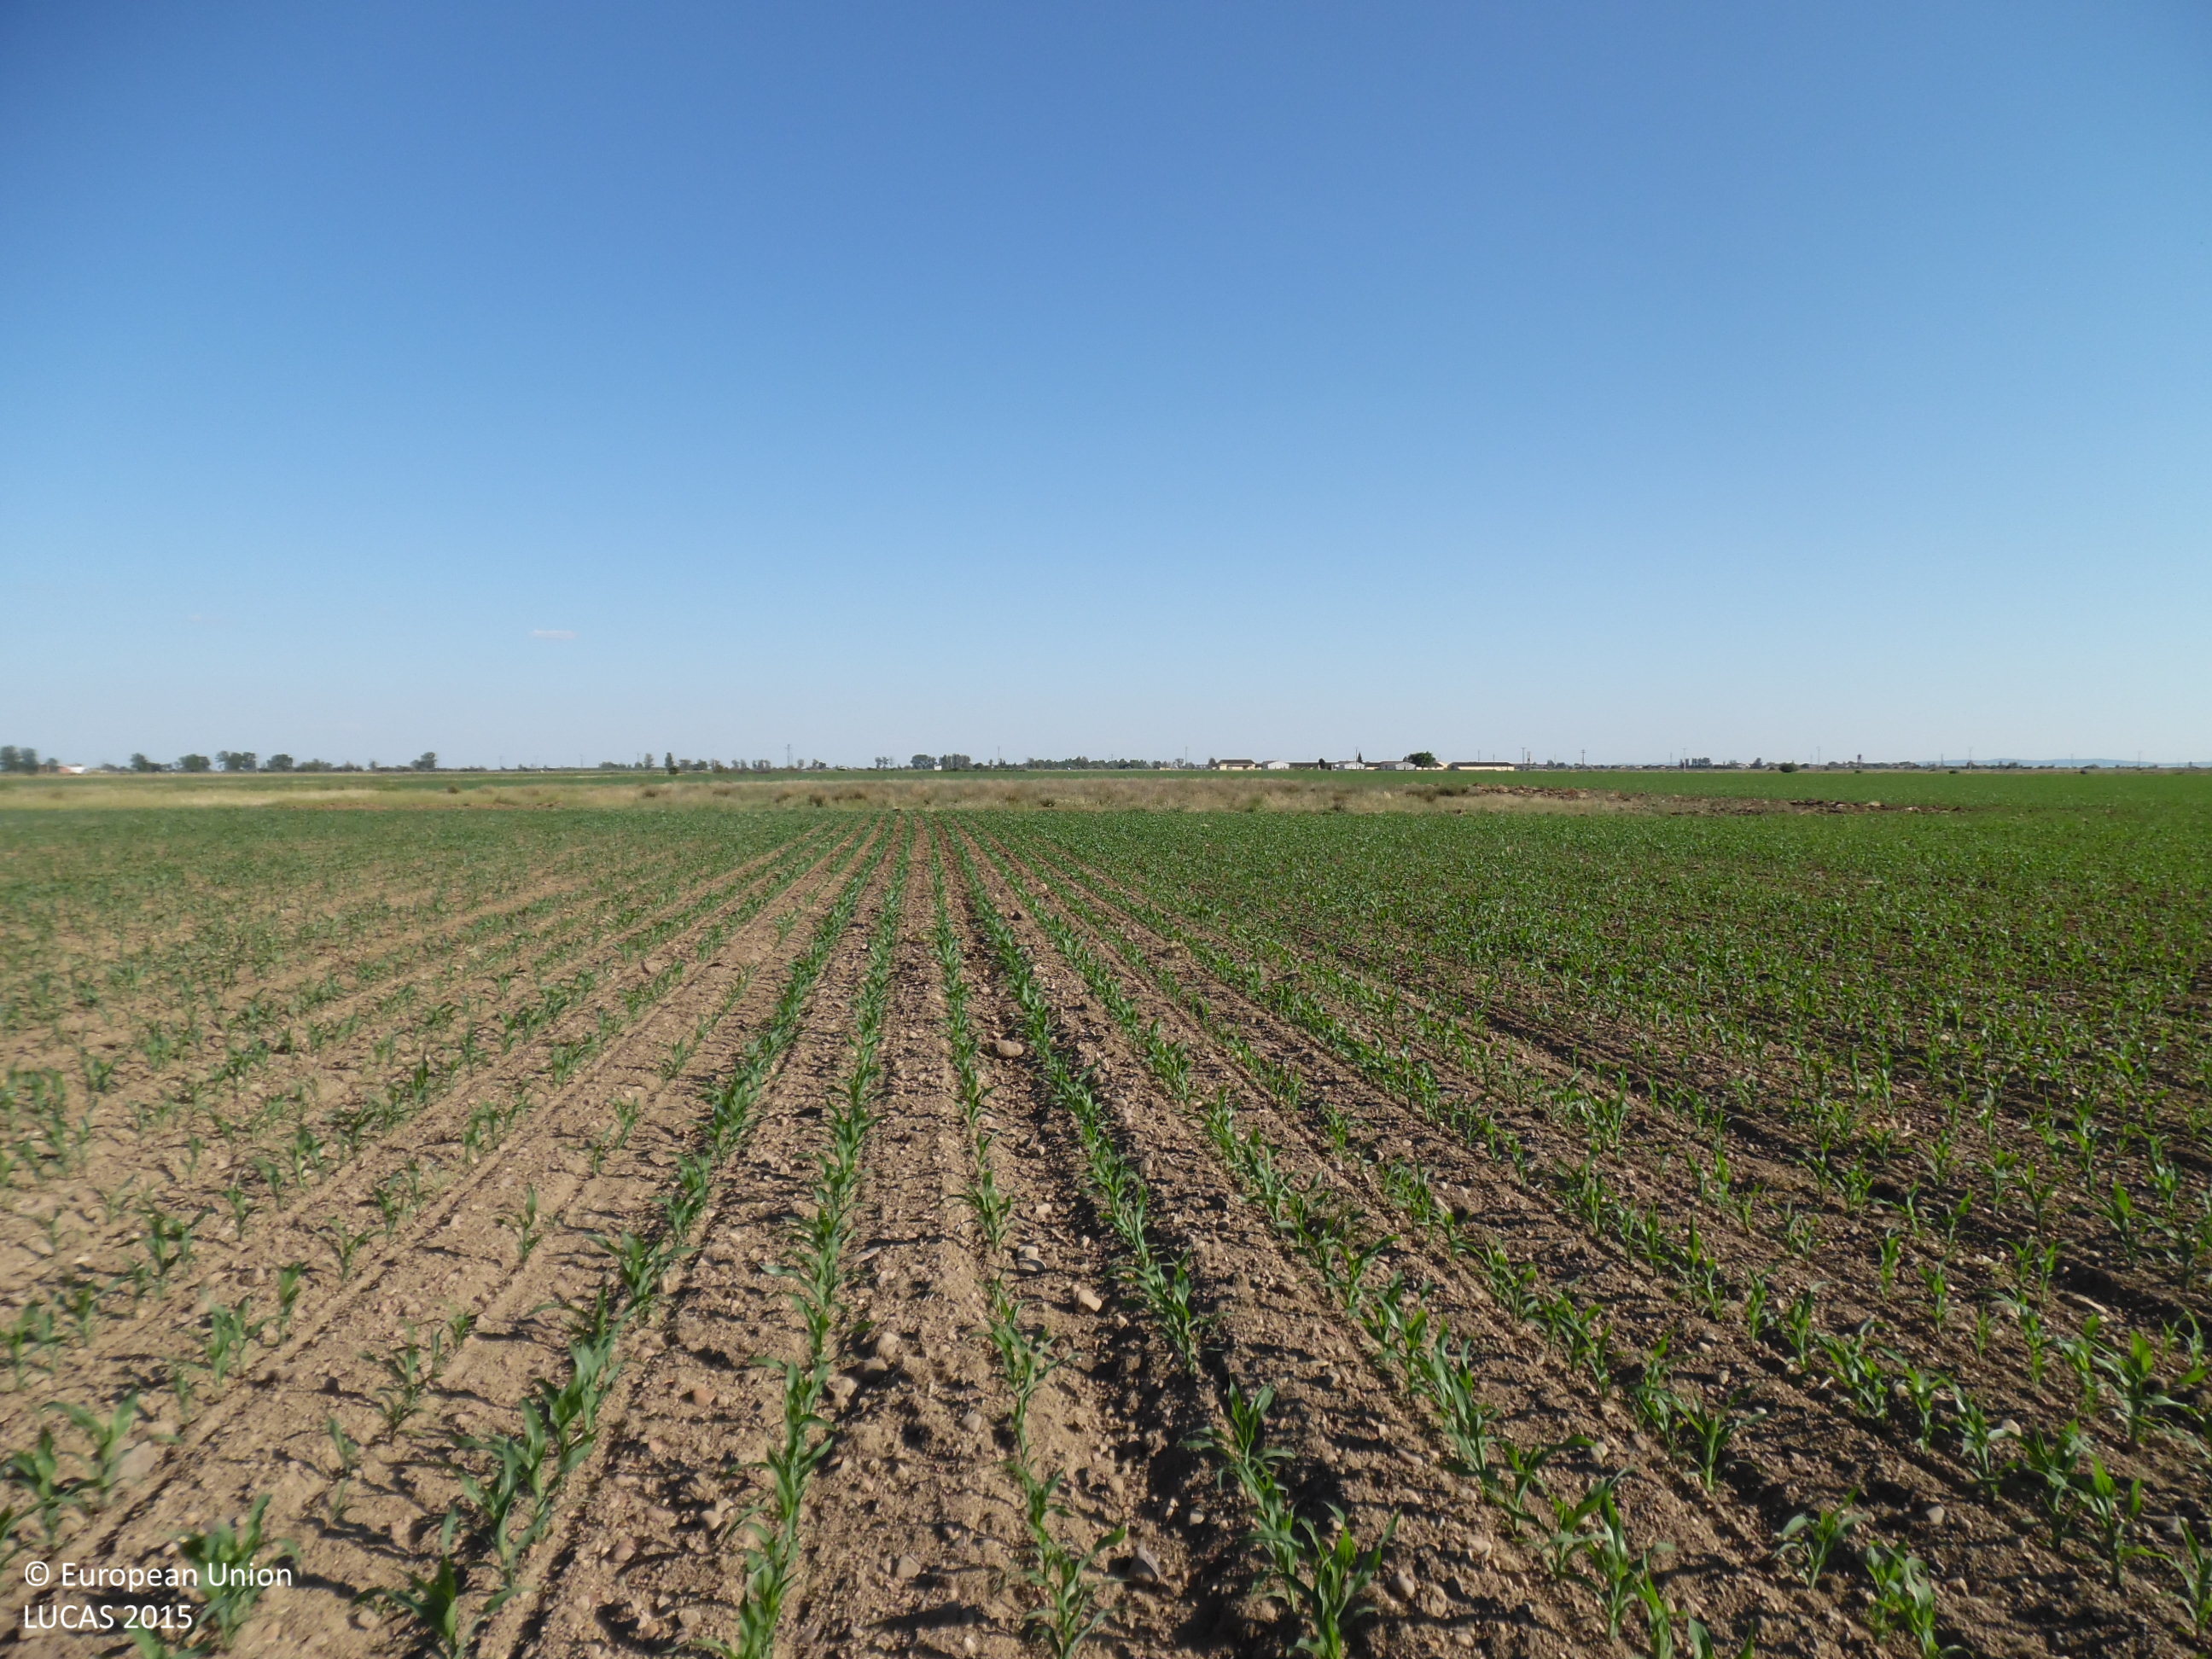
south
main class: Cropland
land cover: Maize
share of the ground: 25 - 50 %
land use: Agriculture (excluding fallow land and kitchen gardens)
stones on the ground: 10 - 25 %
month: June
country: ES
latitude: 42.4734
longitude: -5.7786
